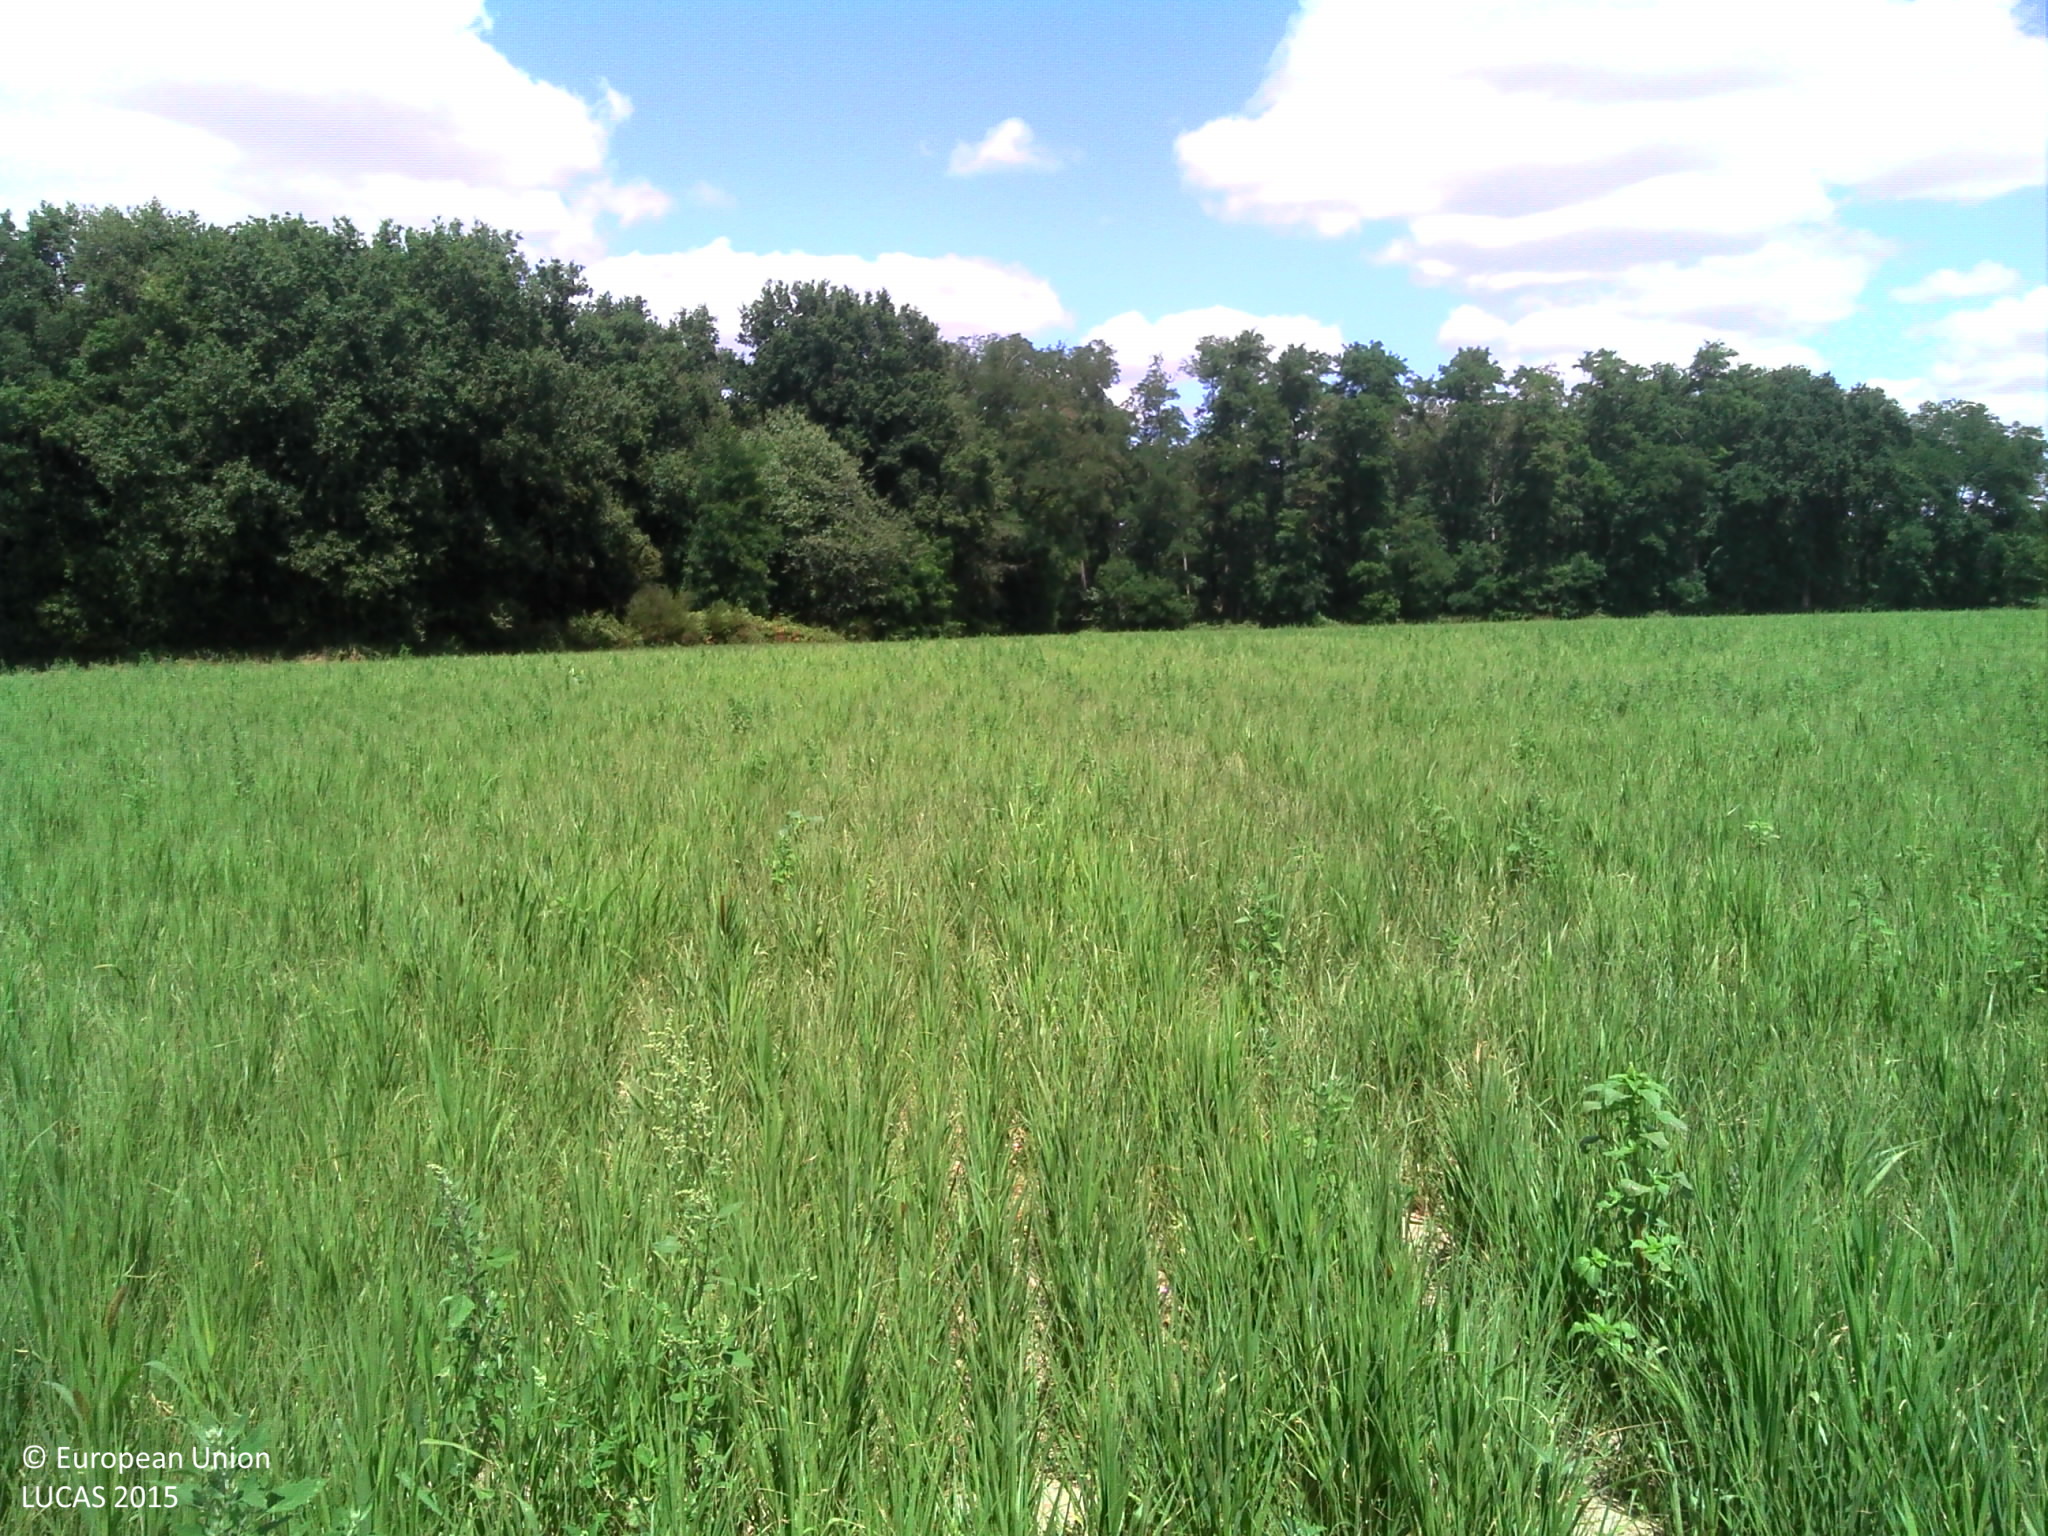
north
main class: Cropland
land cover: Temporary grasslands
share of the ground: > 75 %
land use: Agriculture (excluding fallow land and kitchen gardens)
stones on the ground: < 10 %
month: July
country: FR
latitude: 47.0412
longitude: 0.3848
